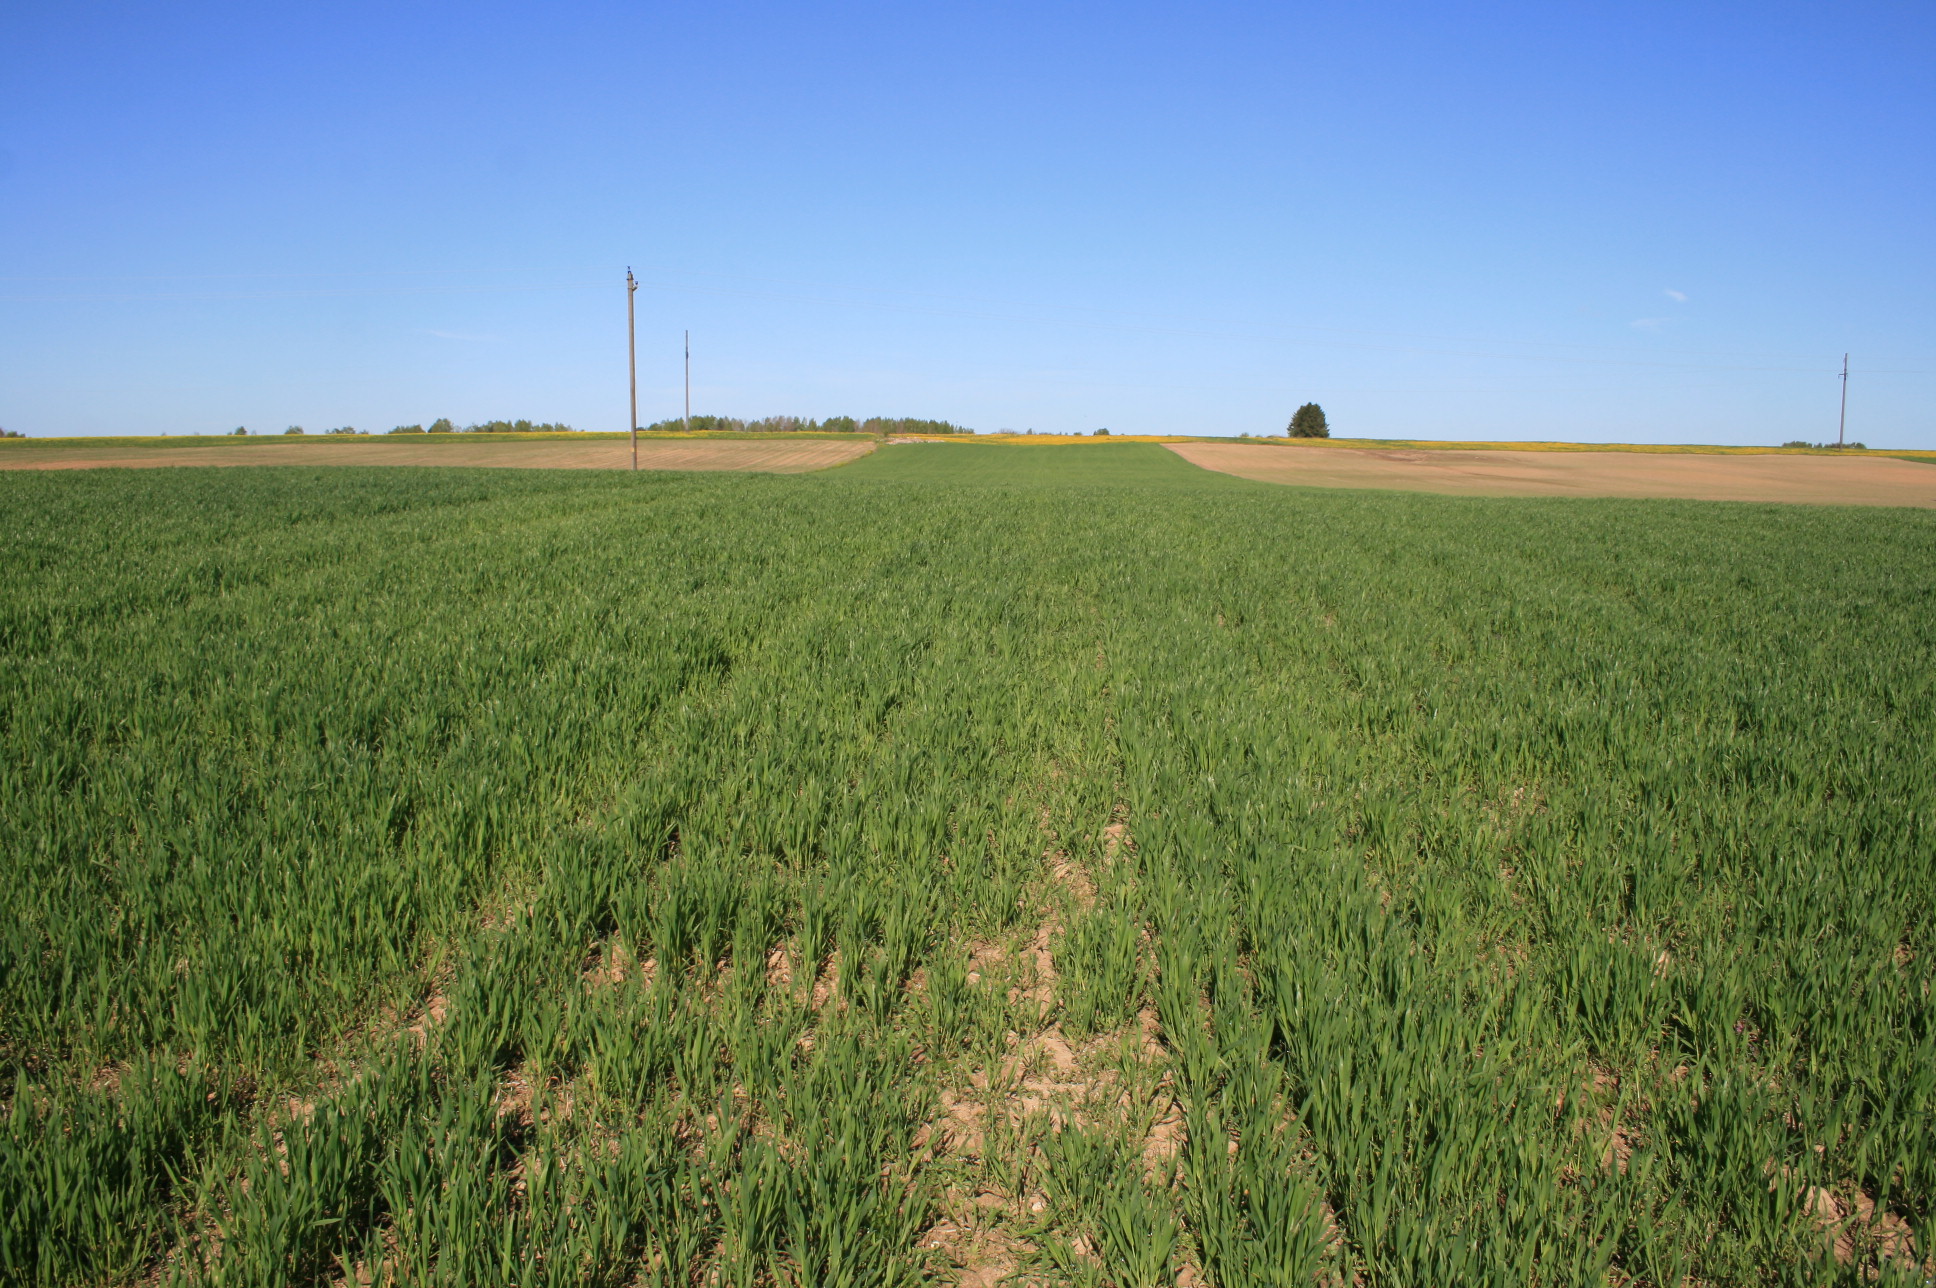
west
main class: Cropland
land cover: Barley
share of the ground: > 75 %
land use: Agriculture (excluding fallow land and kitchen gardens)
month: May
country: LT
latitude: 56.0810
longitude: 21.5658
